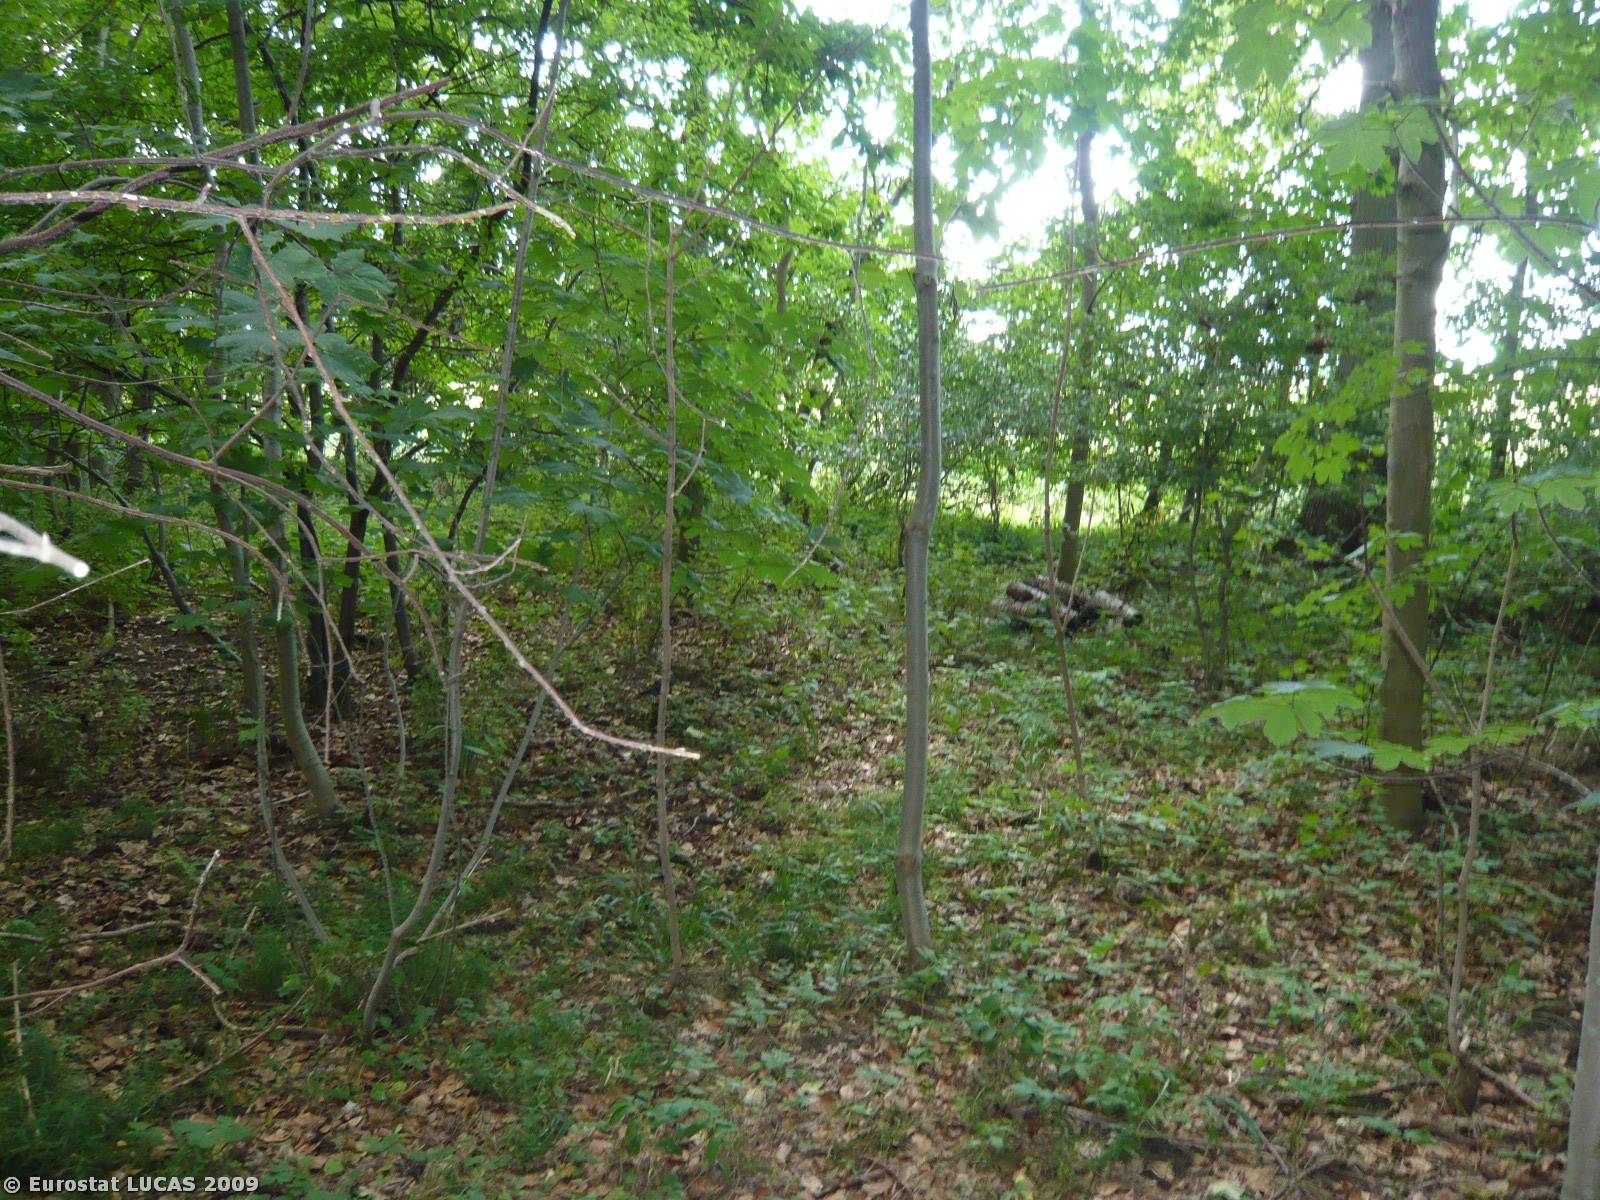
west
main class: Woodland
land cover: Broadleaved woodland
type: mesophytic deciduous forest
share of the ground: > 75 %
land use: Forestry
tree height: > 5 m
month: July
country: DK
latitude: 55.3774
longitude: 10.6149
